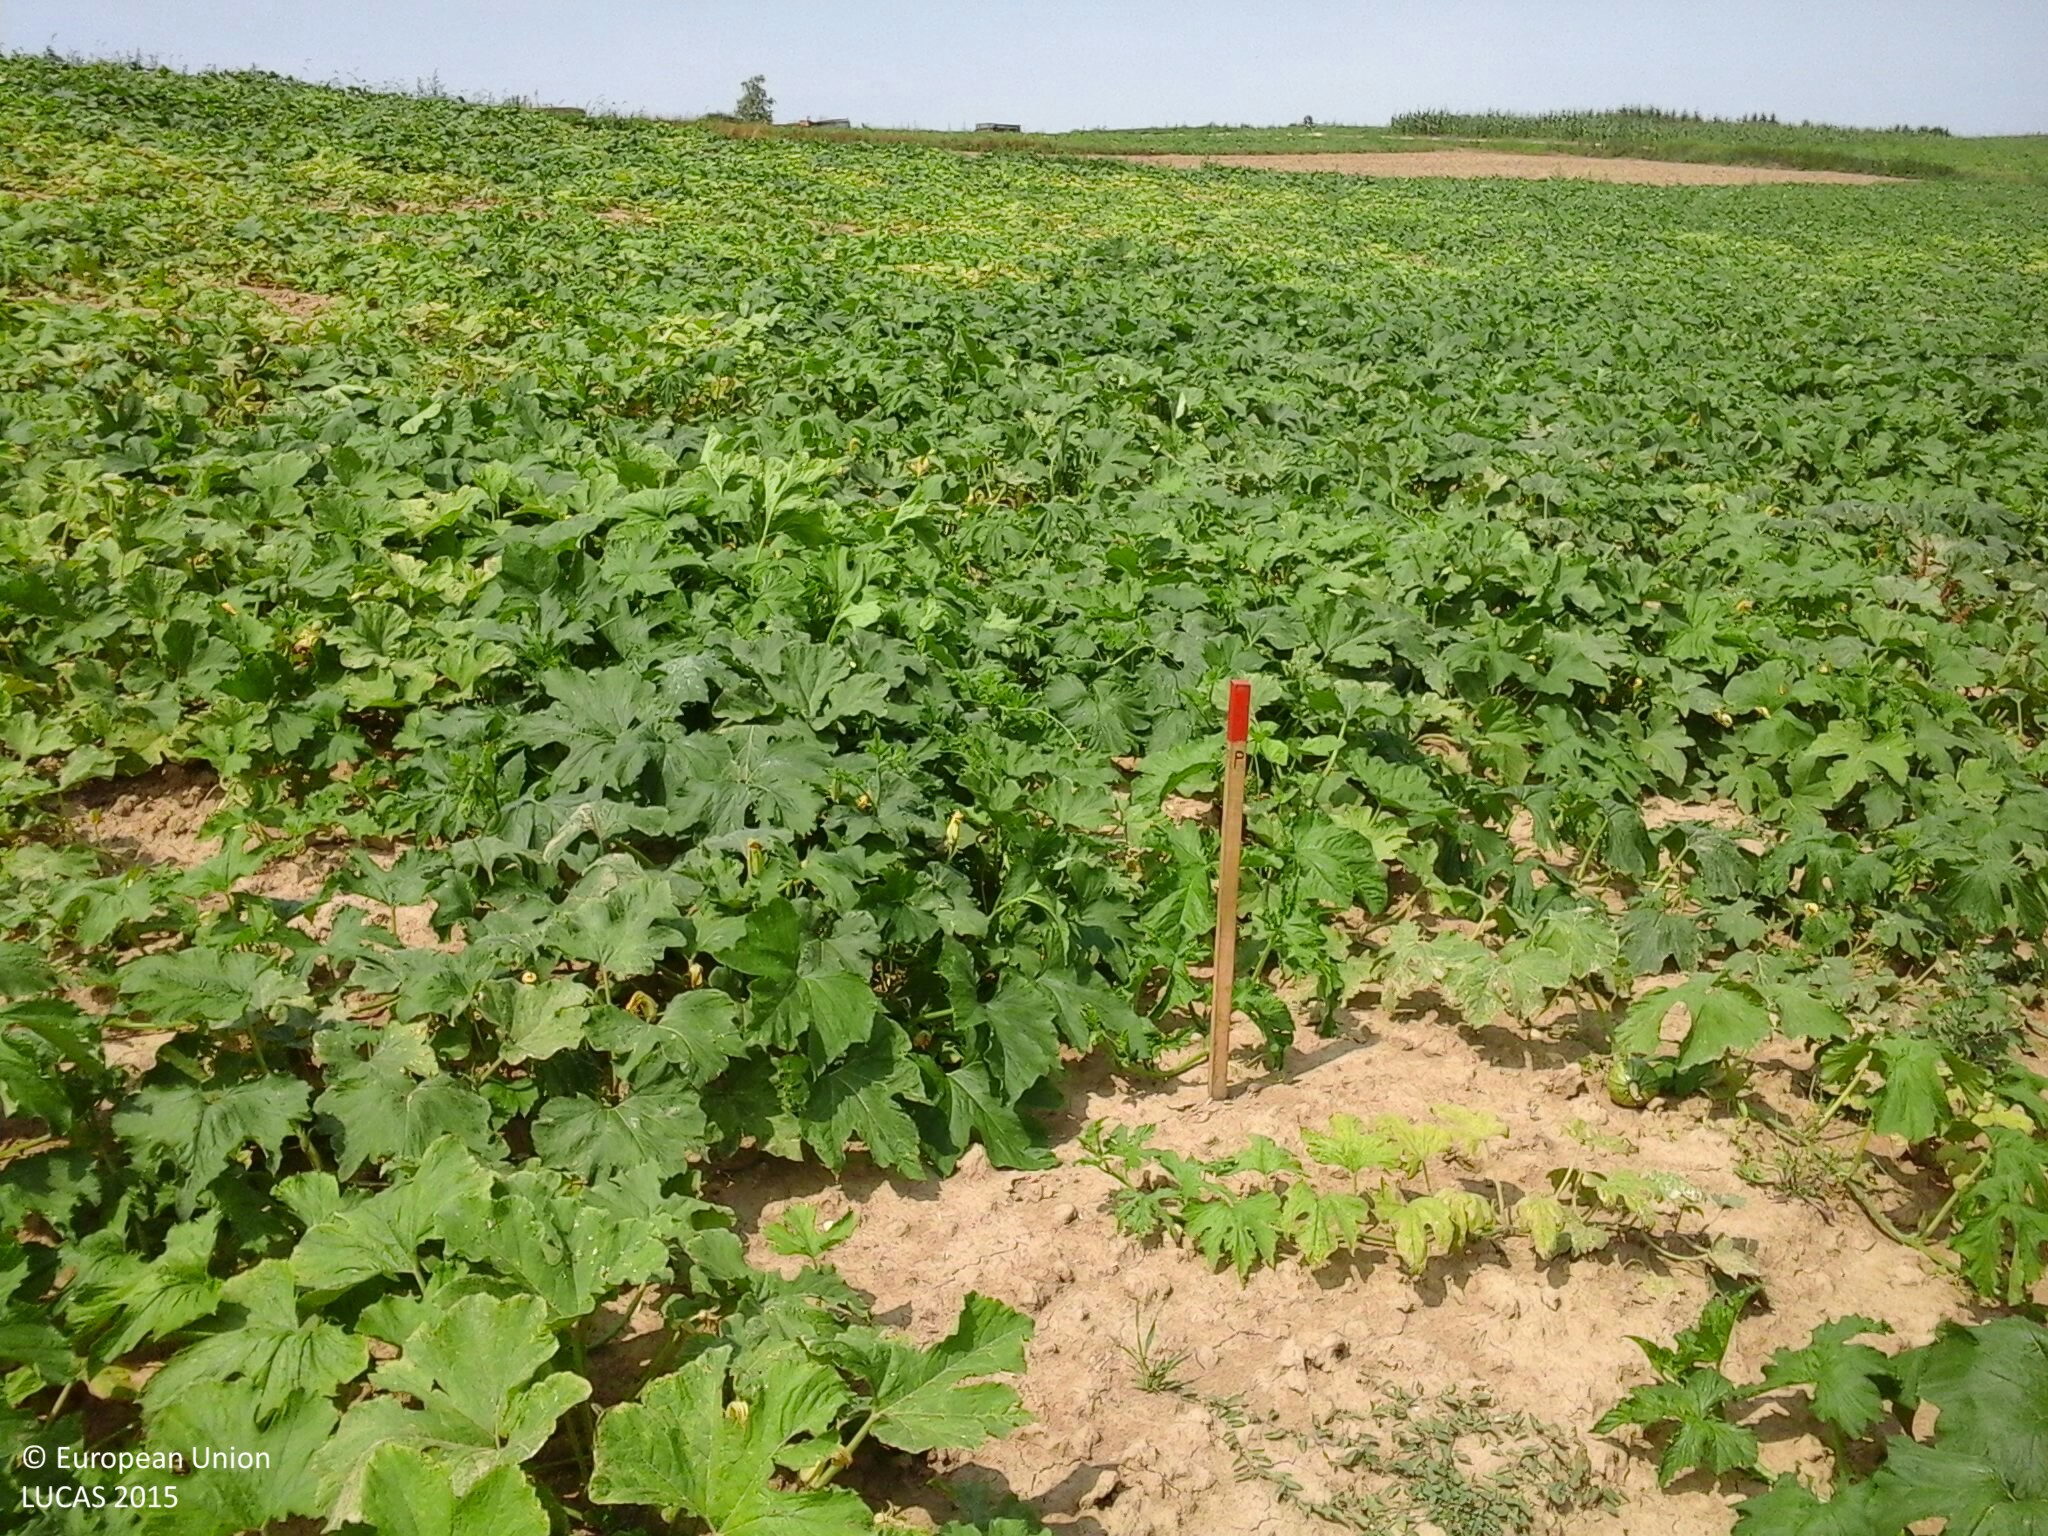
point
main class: Cropland
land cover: Other fresh vegetables
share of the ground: > 75 %
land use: Agriculture (excluding fallow land and kitchen gardens)
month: July
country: HU
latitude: 46.9004
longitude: 16.3947
